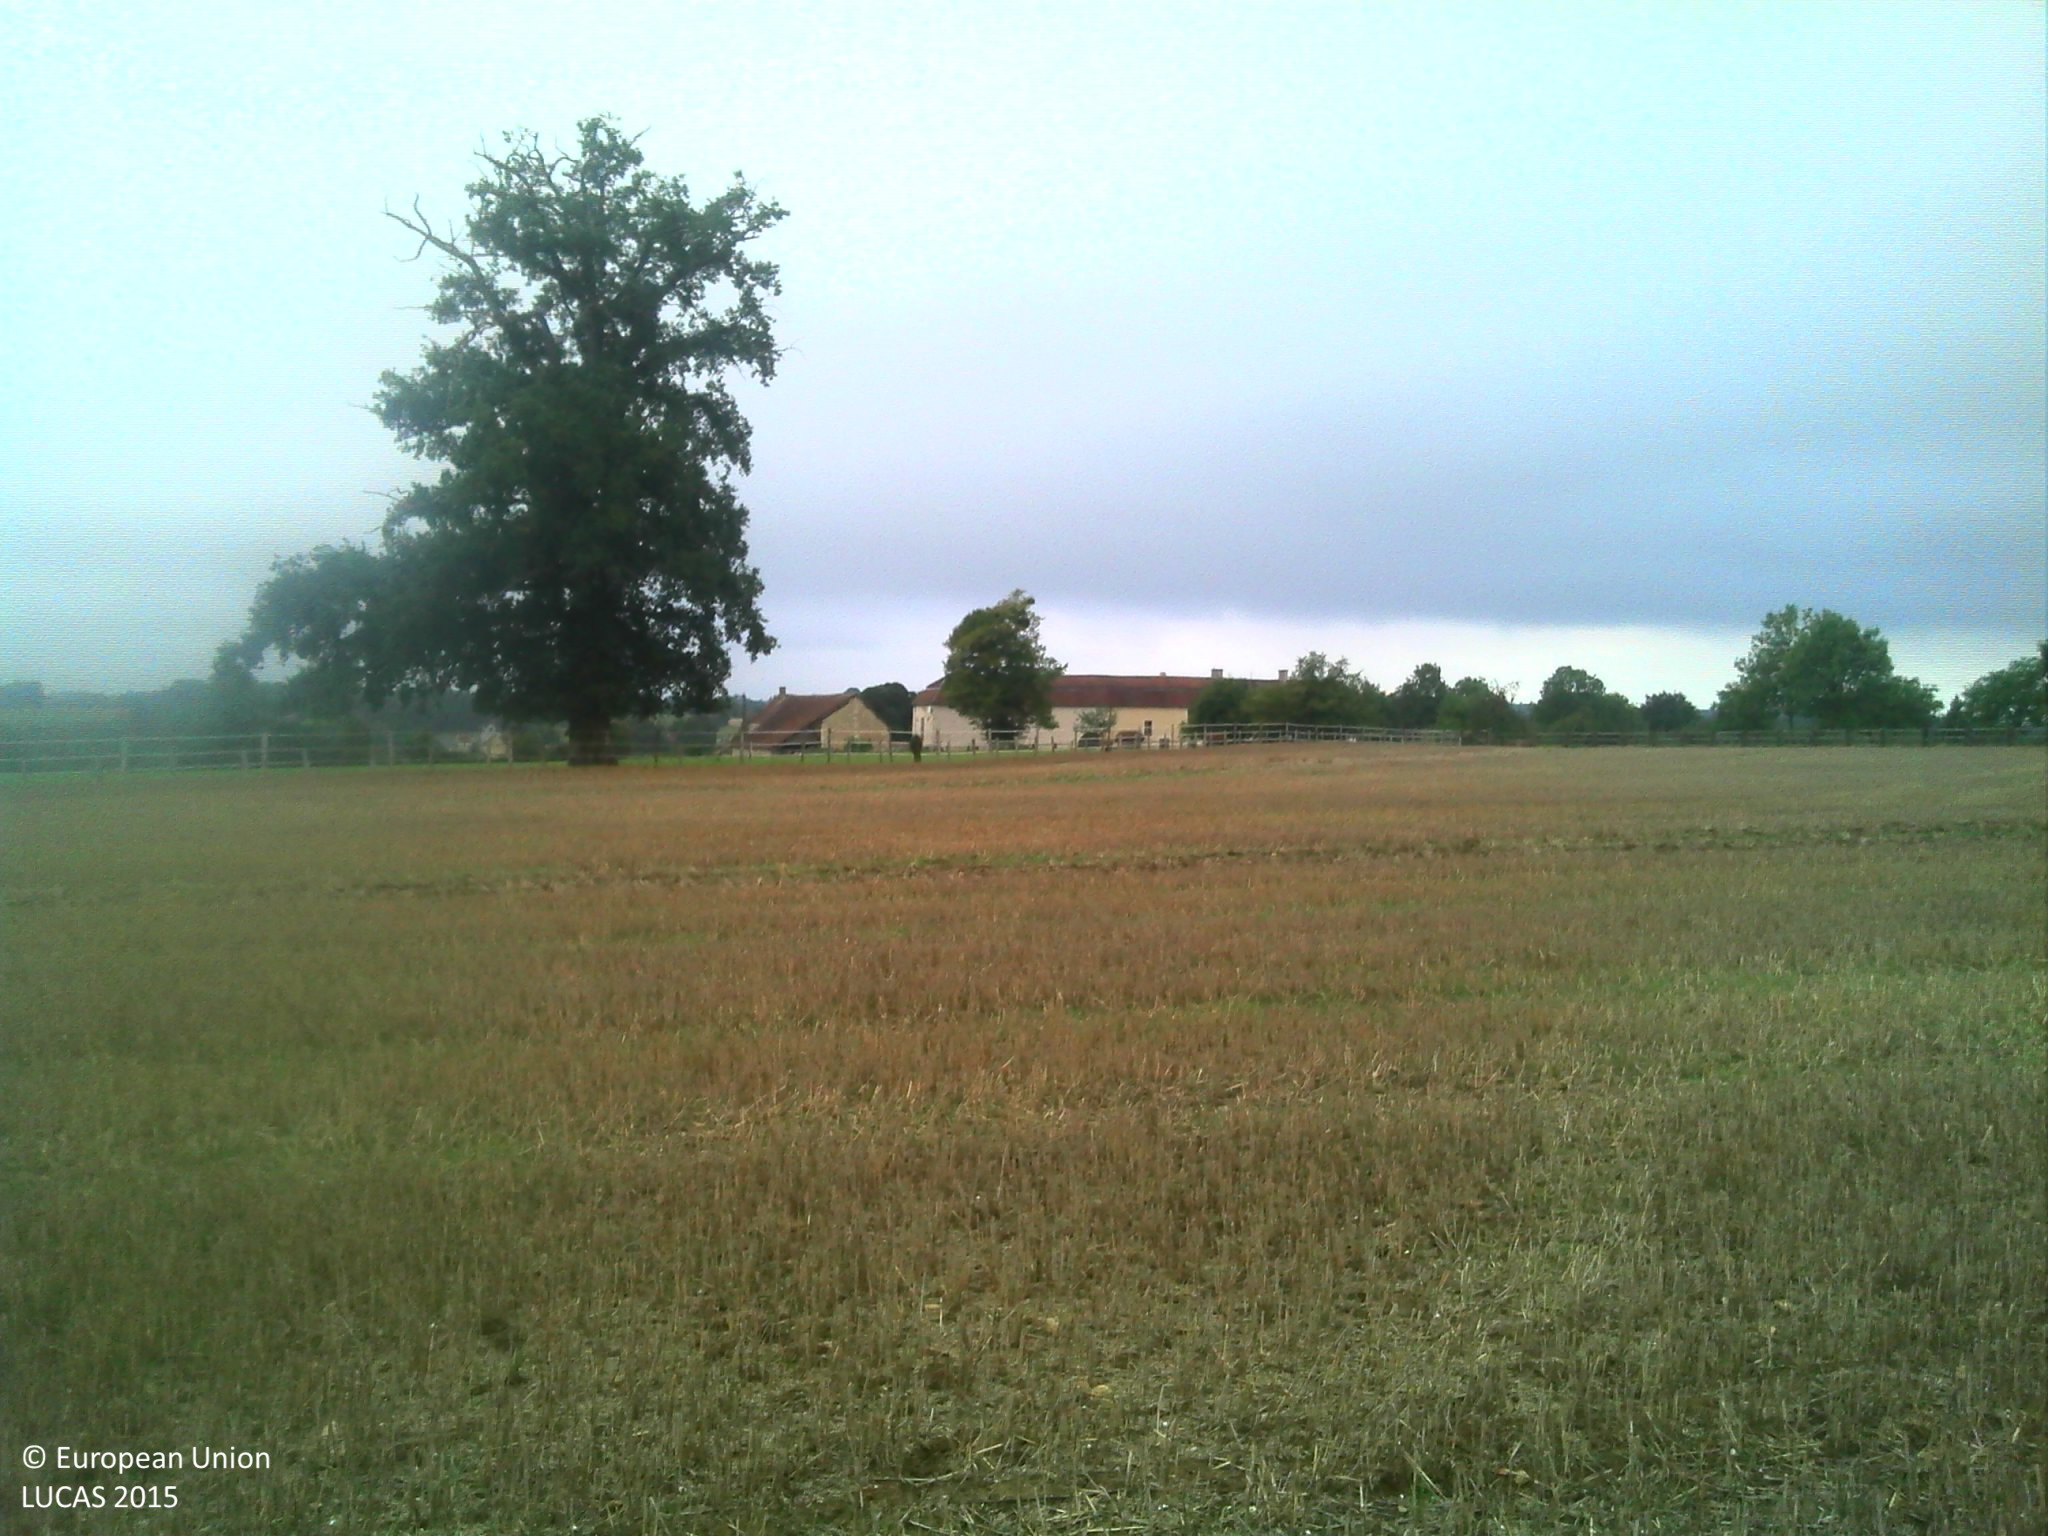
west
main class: Cropland
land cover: Common wheat
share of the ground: < 10 %
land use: Agriculture (excluding fallow land and kitchen gardens)
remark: Harvested field
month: August
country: FR
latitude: 48.4866
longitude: 0.5451
